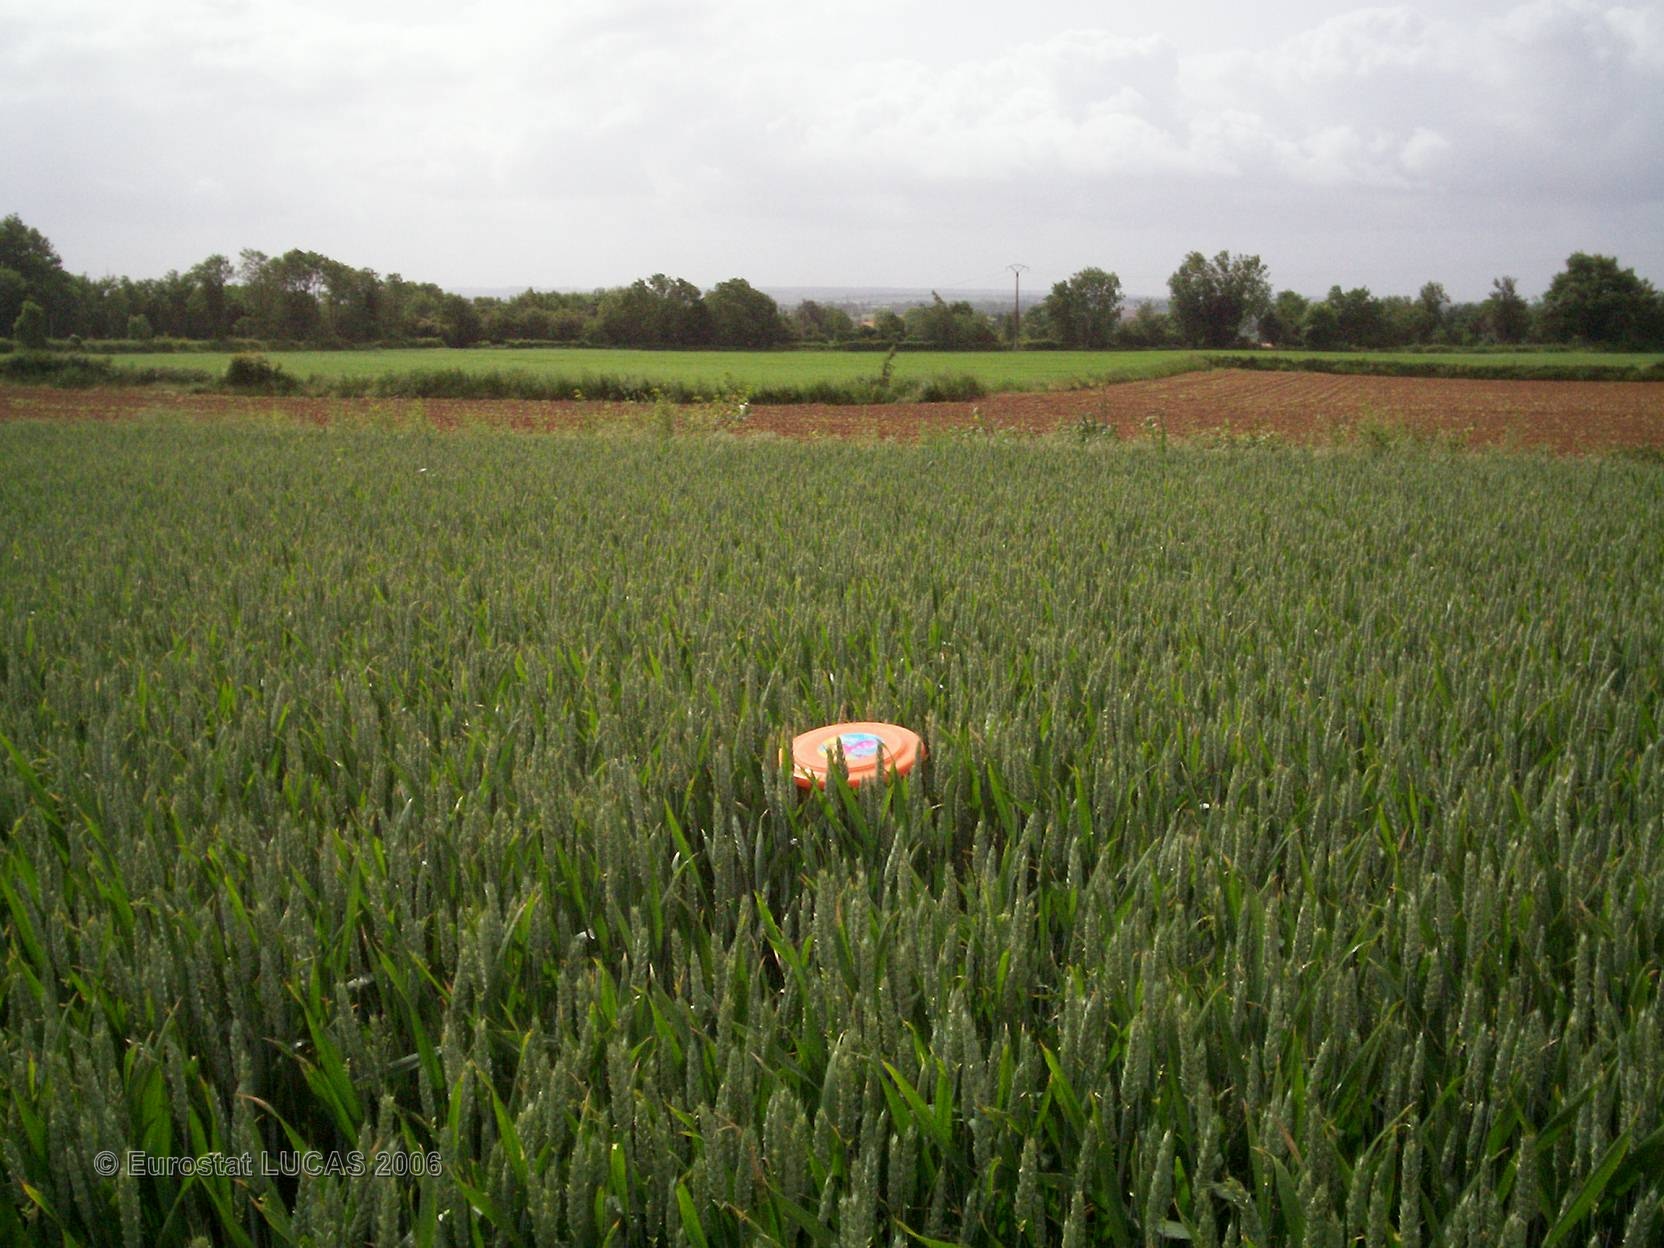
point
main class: Cropland
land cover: Common wheat
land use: Agriculture (excluding fallow land and kitchen gardens)
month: May
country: FR
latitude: 46.4391
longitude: -0.2411
